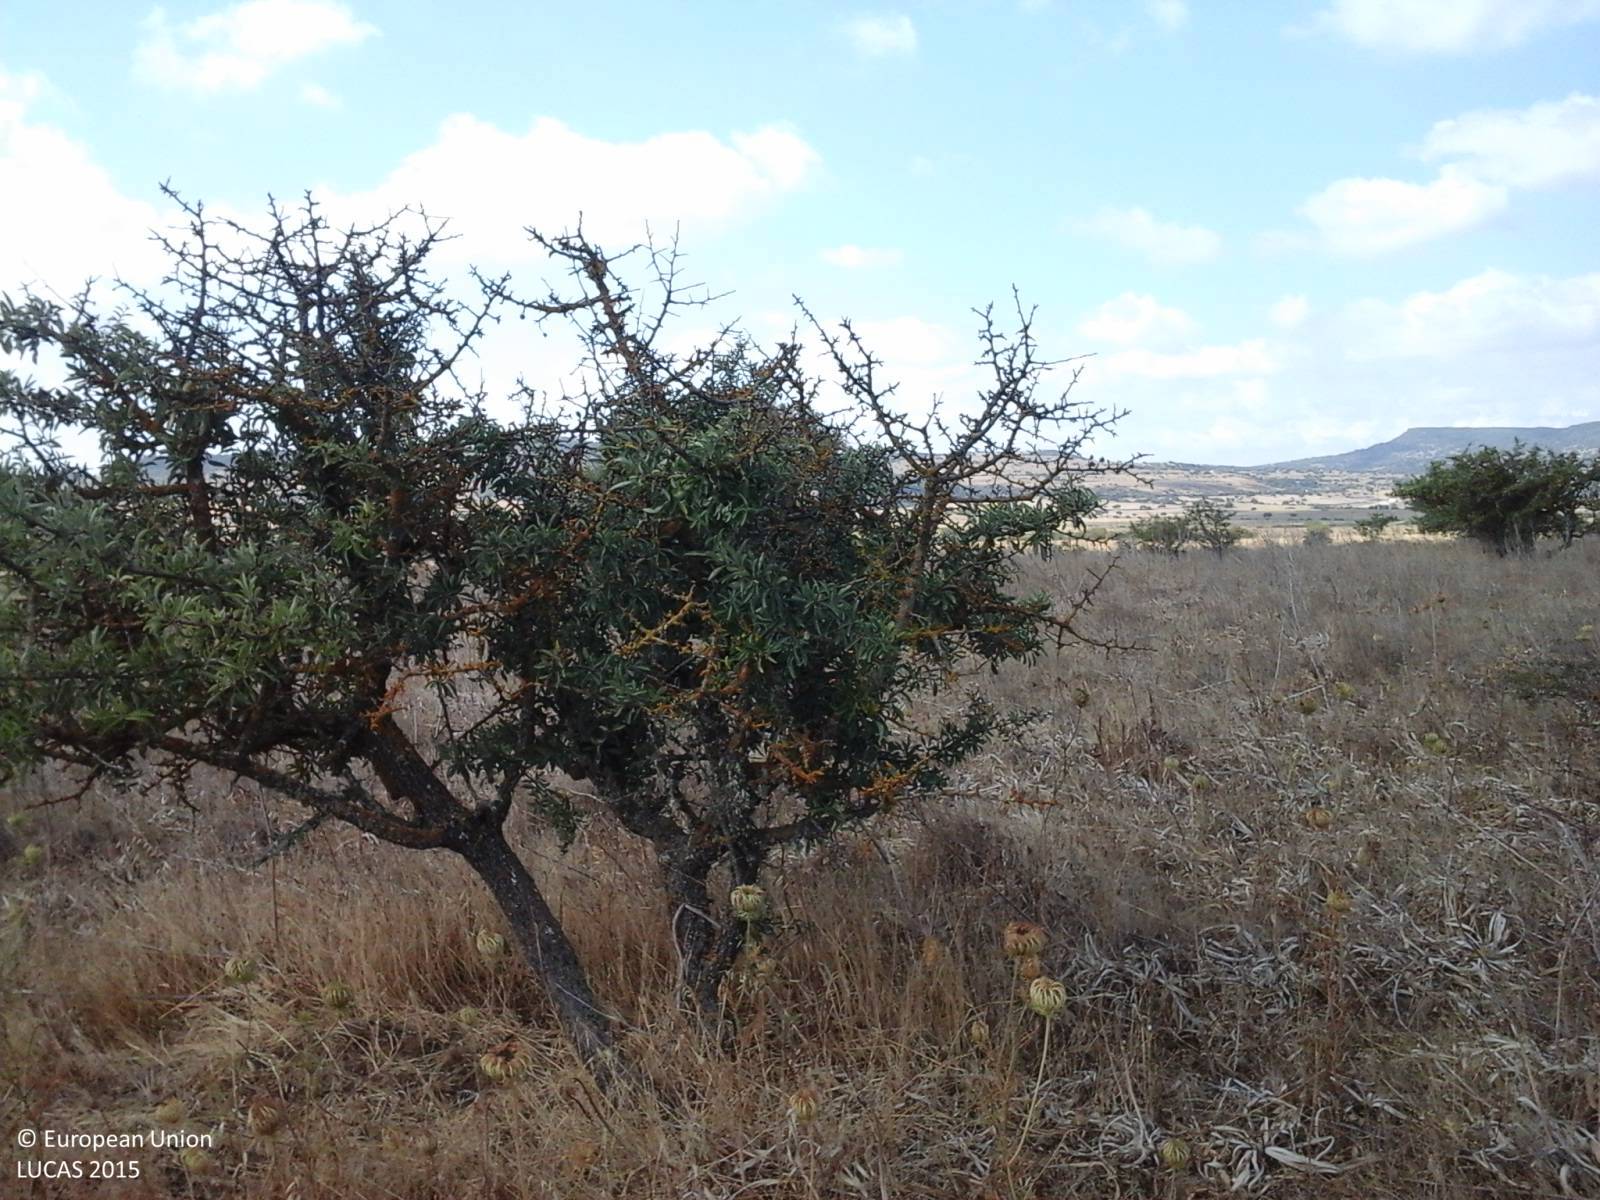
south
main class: Grassland
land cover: Grassland with sparse tree/shrub cover
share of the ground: 25 - 50 %
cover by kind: herbaceous plants 95 %, broadleaved forest trees 5 %
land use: Agriculture (excluding fallow land and kitchen gardens)
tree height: < 5 m
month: July
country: IT
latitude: 40.6956
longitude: 8.9048
